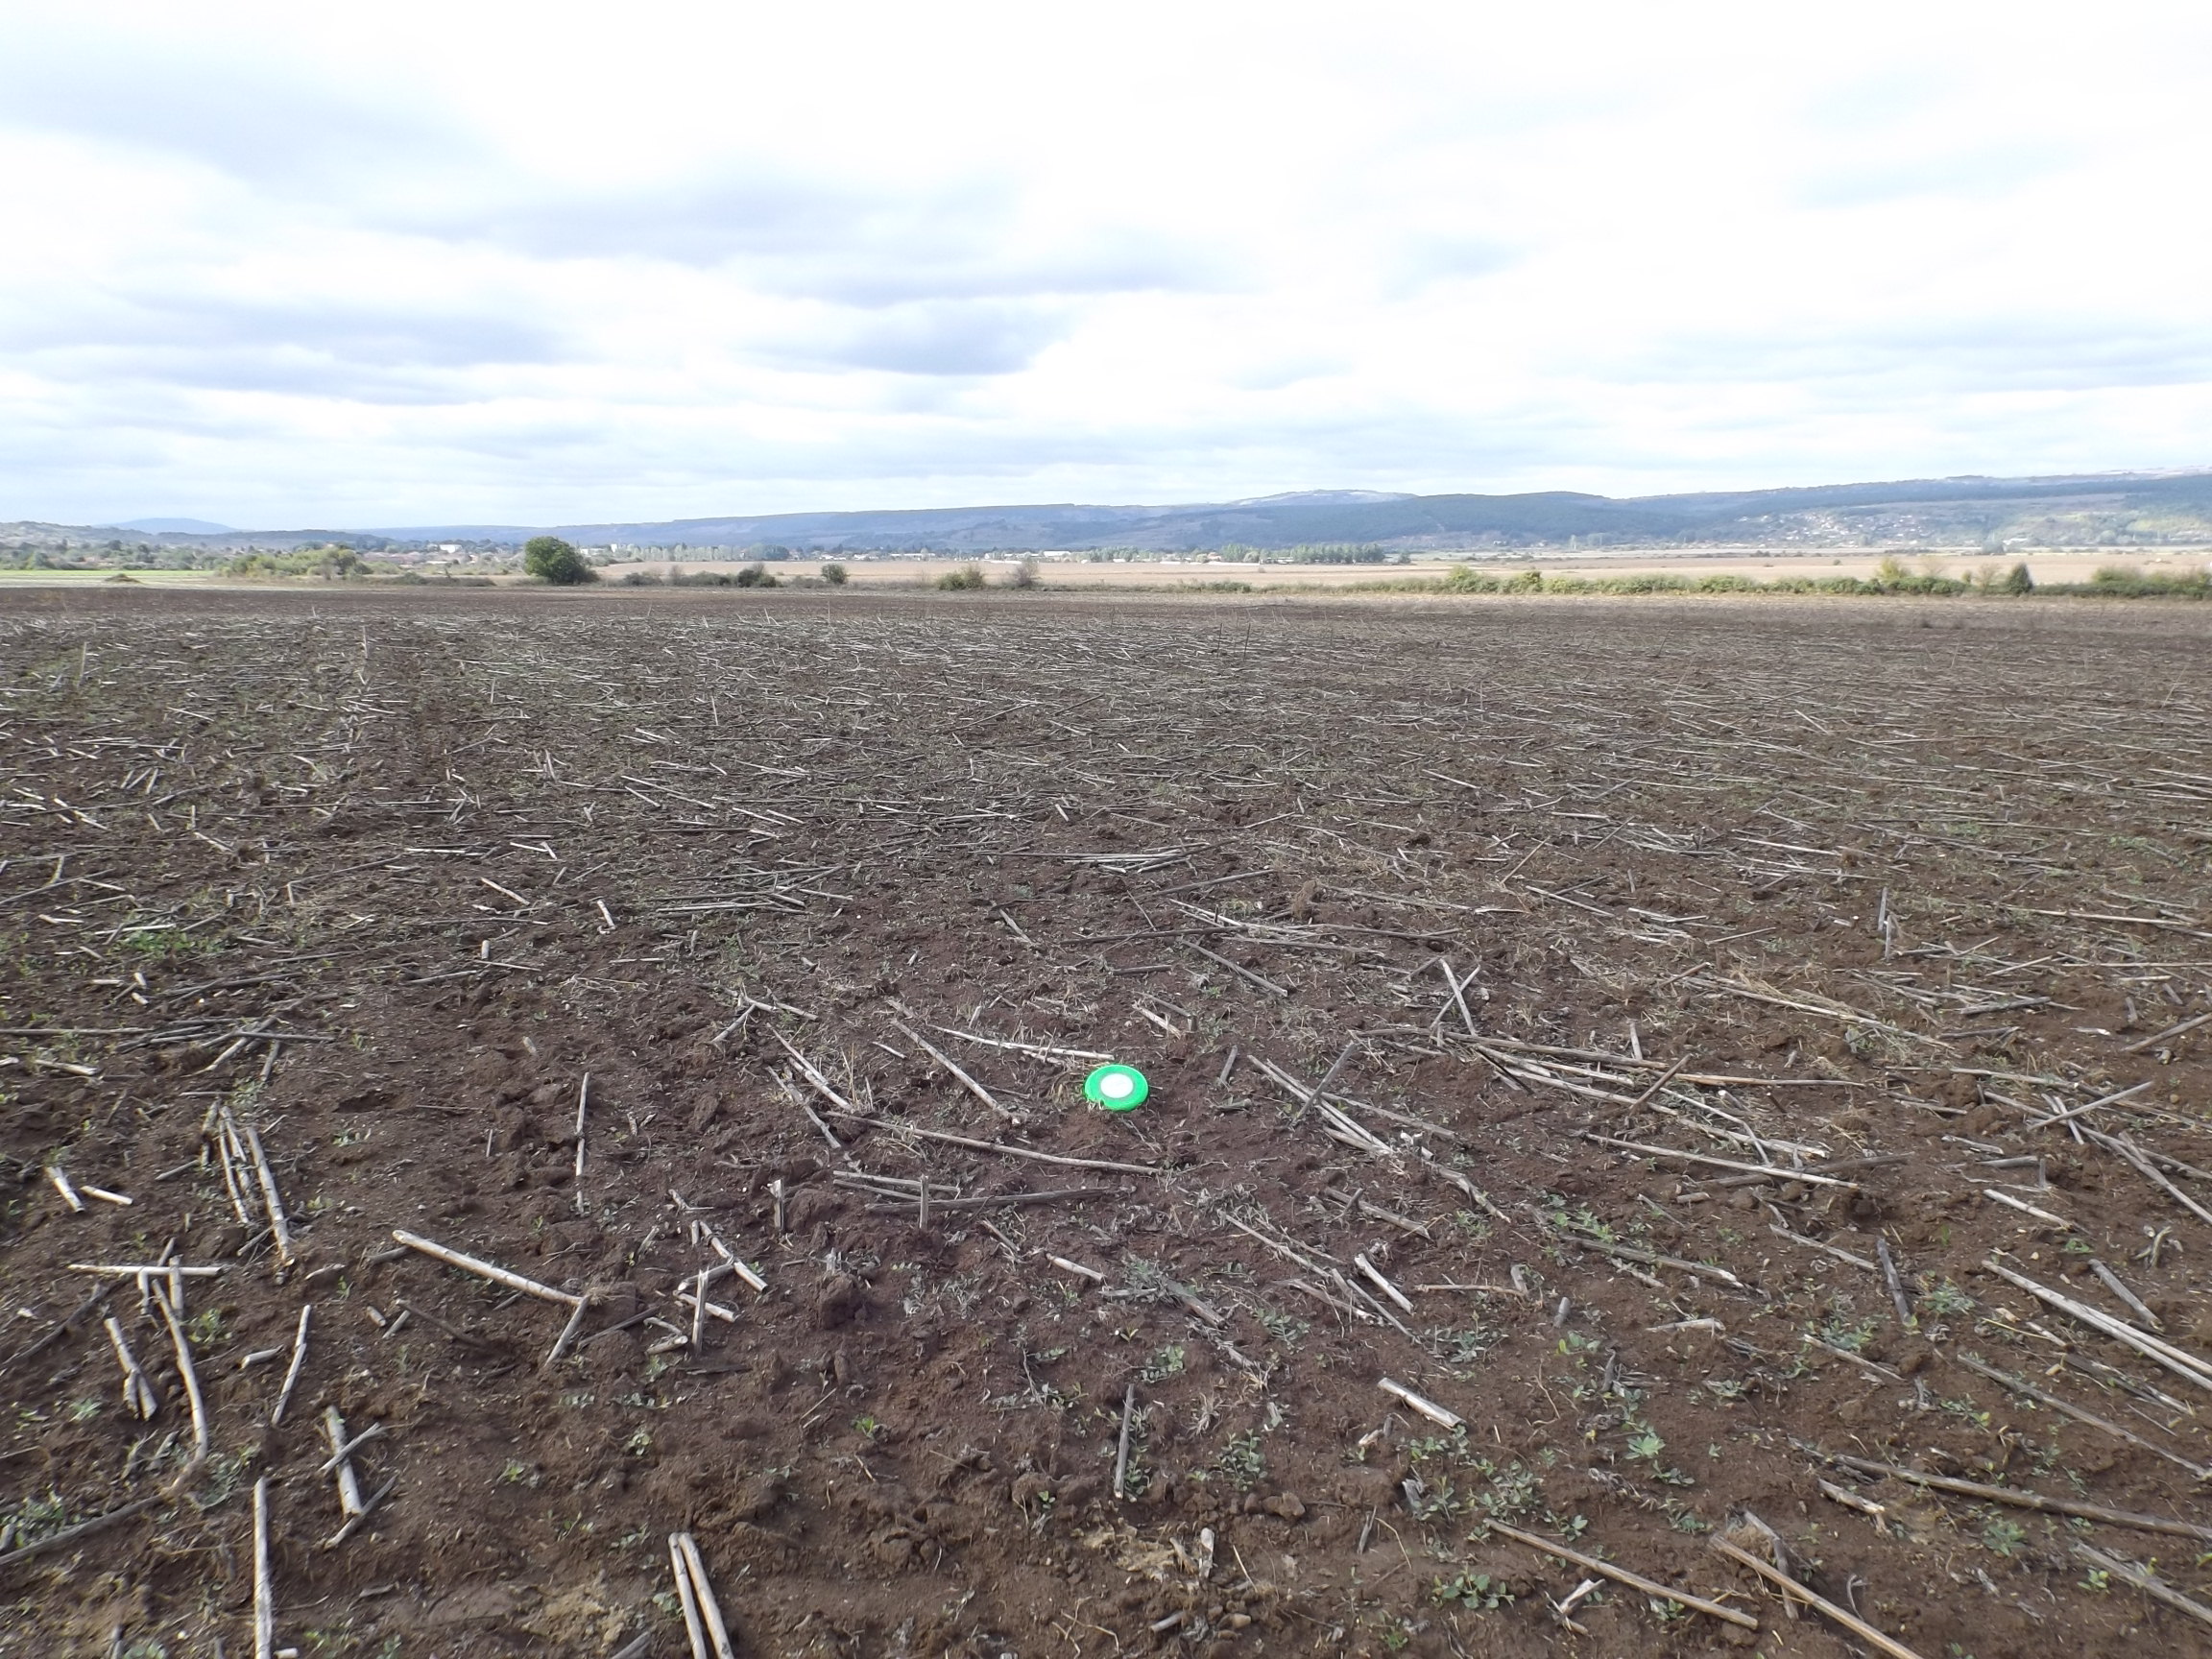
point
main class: Cropland
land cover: Sunflower
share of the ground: < 10 %
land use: Agriculture (excluding fallow land and kitchen gardens)
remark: Harvested field
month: September
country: BG
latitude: 43.0215
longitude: 27.4628
